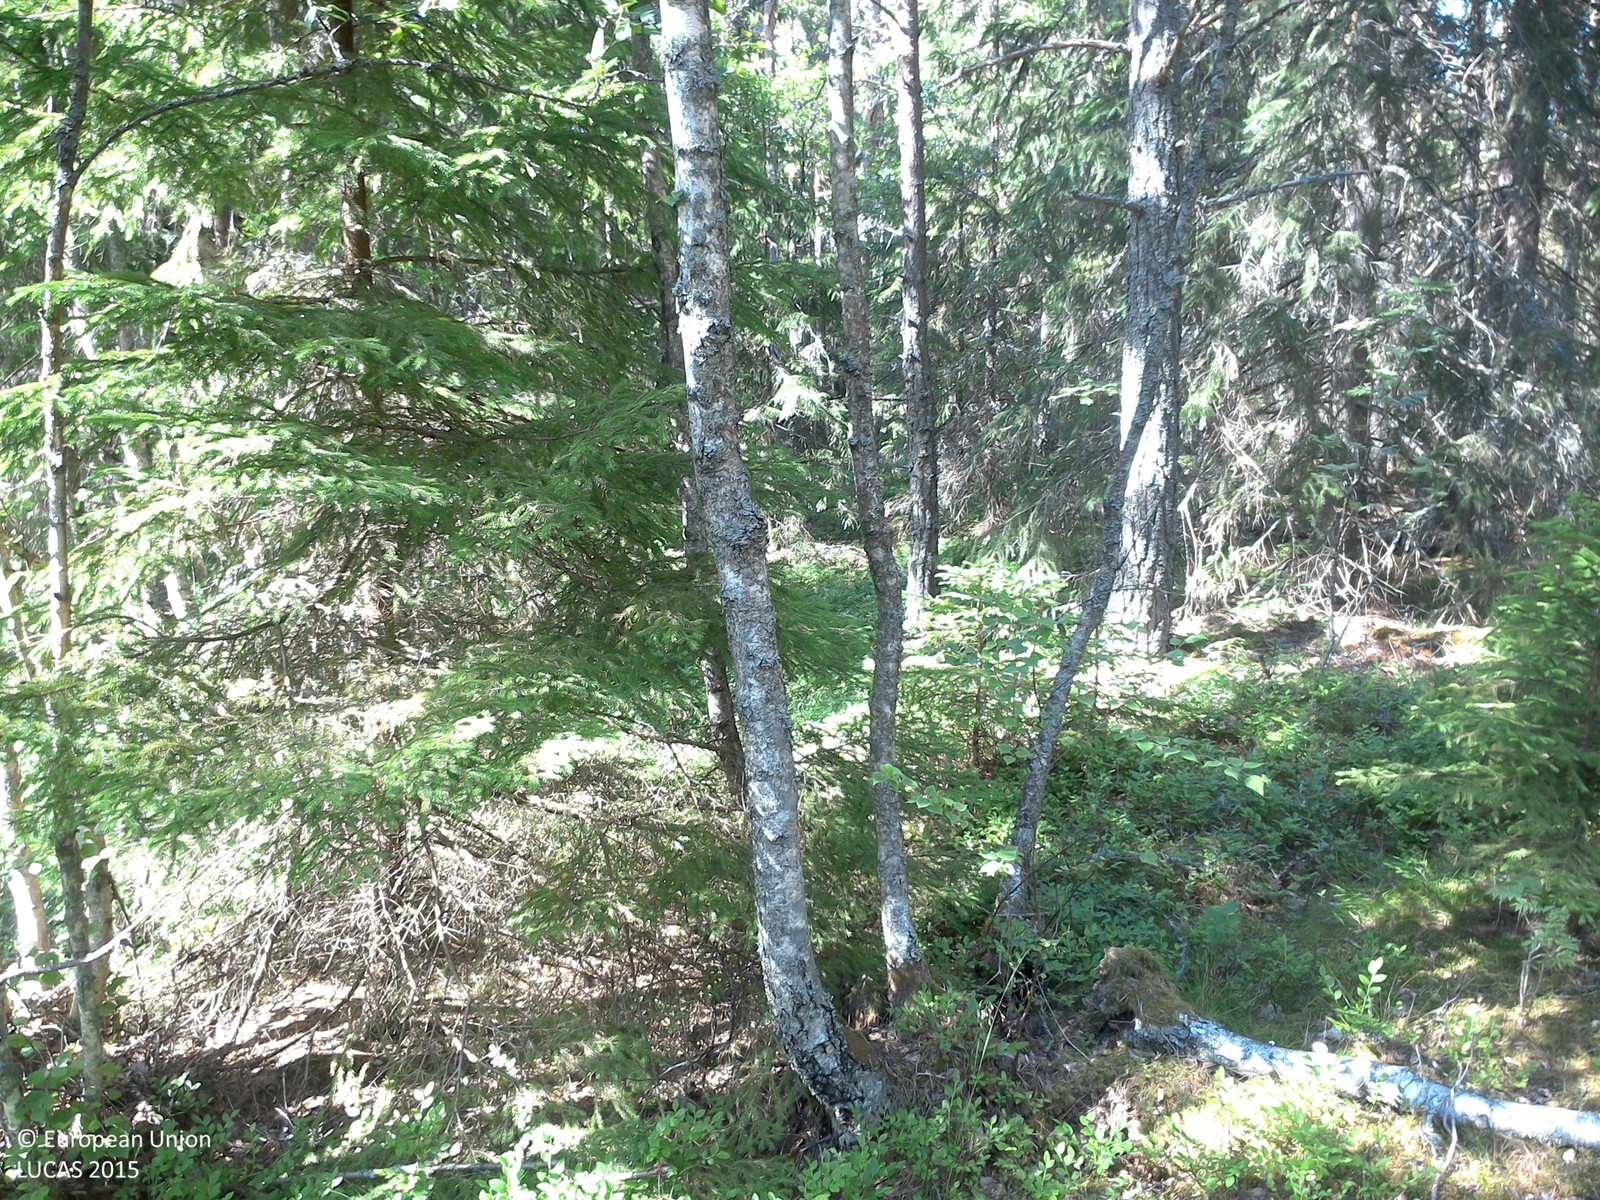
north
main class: Woodland
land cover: Pine dominated coniferous woodland
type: boreal forest
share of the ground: 50 - 75 %
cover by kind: coniferous forest trees 65 %, lichens and mosses 20 %, herbaceous plants 10 %, broadleaved forest trees 5 %
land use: Forestry
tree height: > 5 m
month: June
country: SE
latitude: 58.2499
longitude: 15.5323
